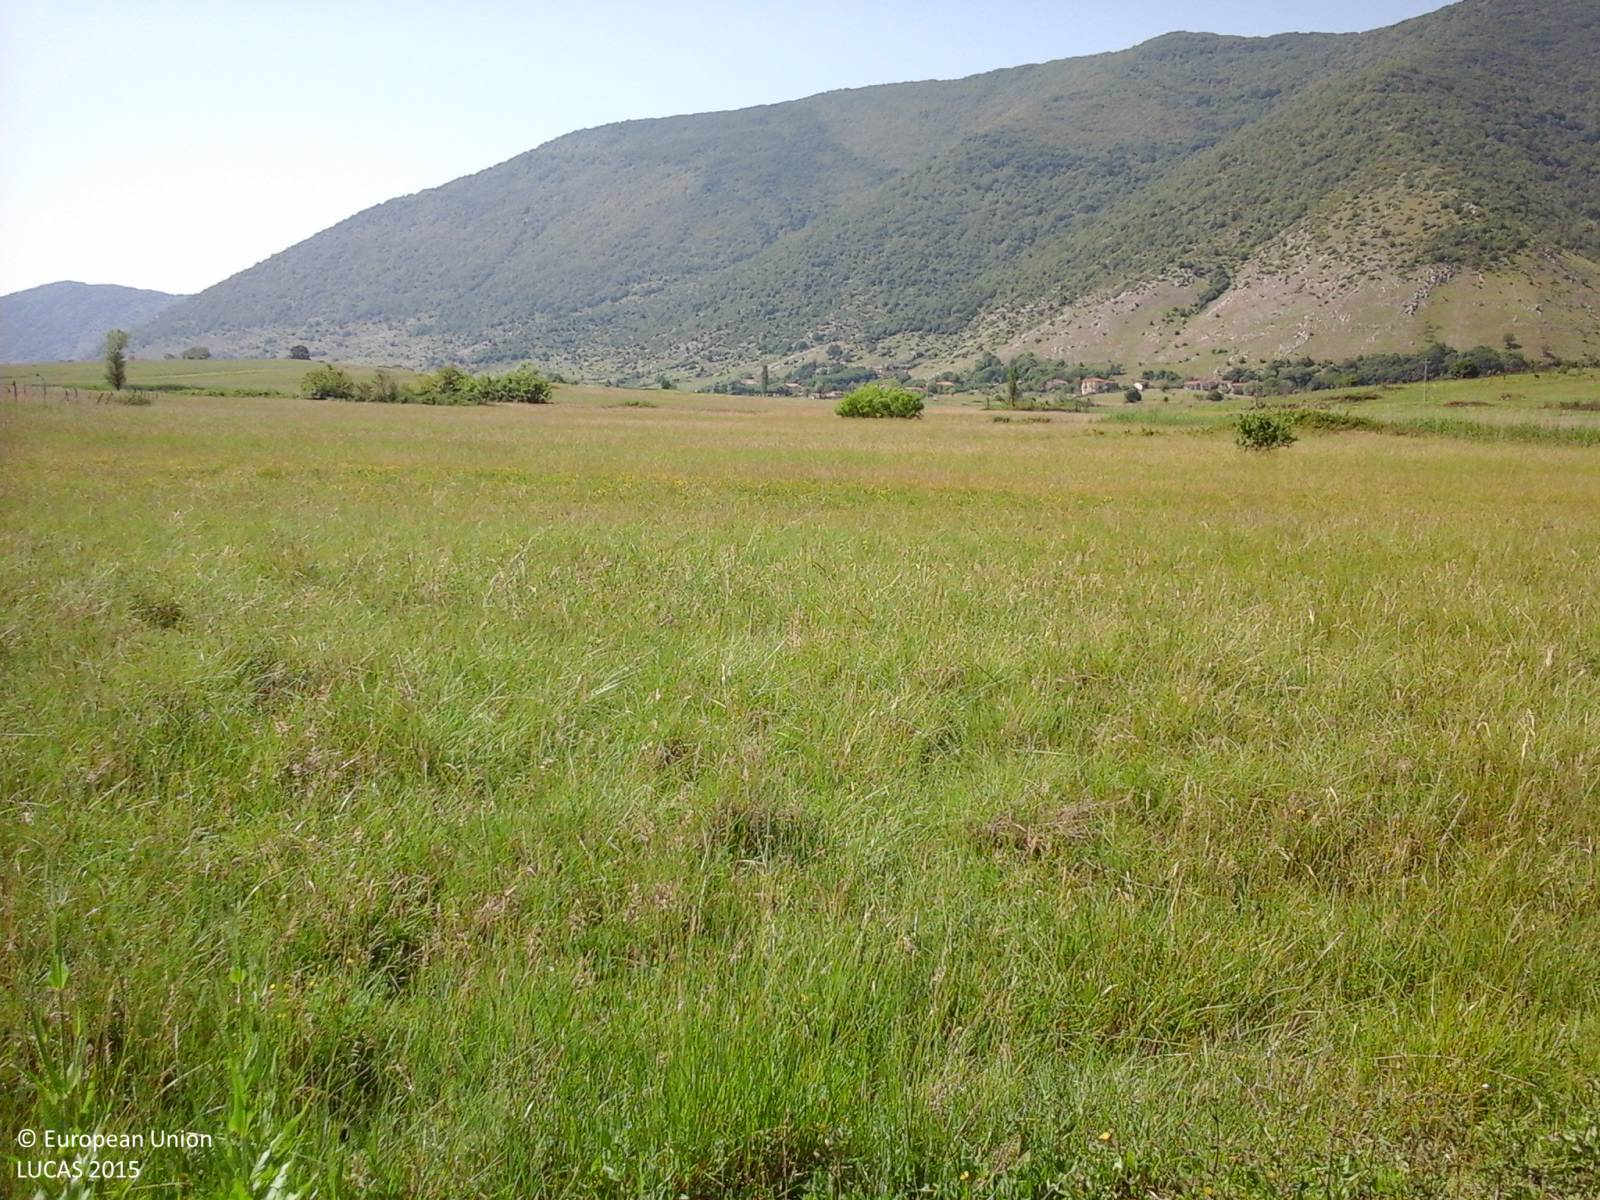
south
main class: Grassland
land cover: Spontaneously vegetated surfaces
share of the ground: > 75 %
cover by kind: herbaceous plants 100 %
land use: Fallow land
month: June
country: IT
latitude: 42.0010
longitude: 13.3807
